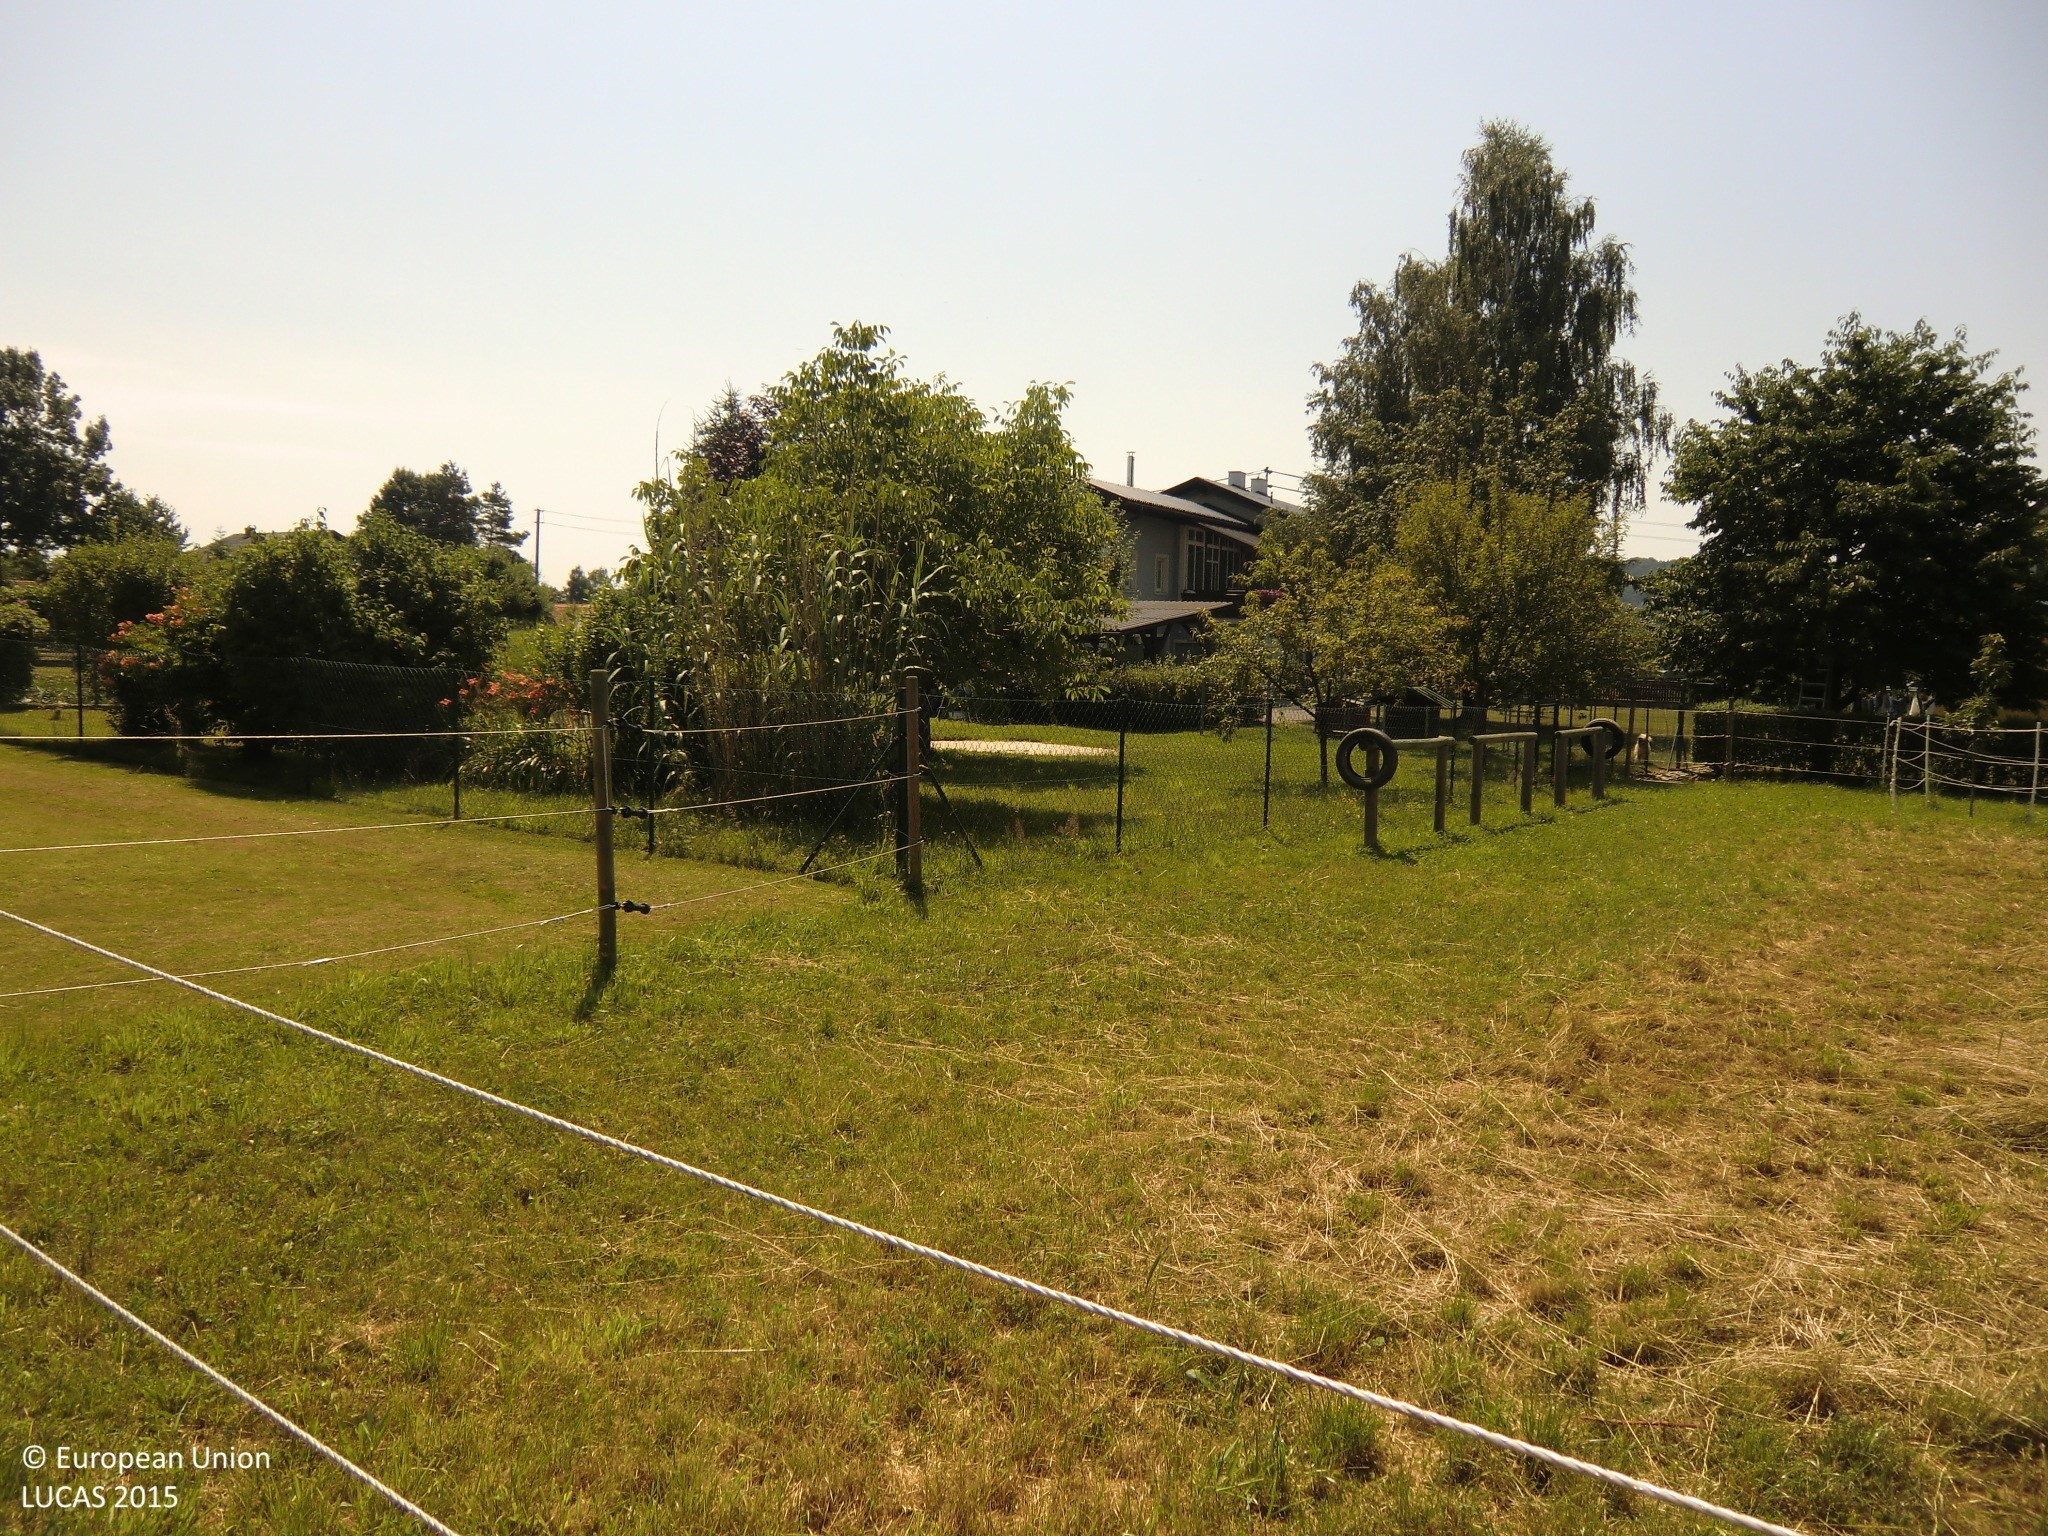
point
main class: Grassland
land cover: Grassland with sparse tree/shrub cover
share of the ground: > 75 %
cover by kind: herbaceous plants 95 %, coniferous forest trees 5 %
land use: Residential
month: July
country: AT
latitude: 47.0887
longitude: 15.9421
